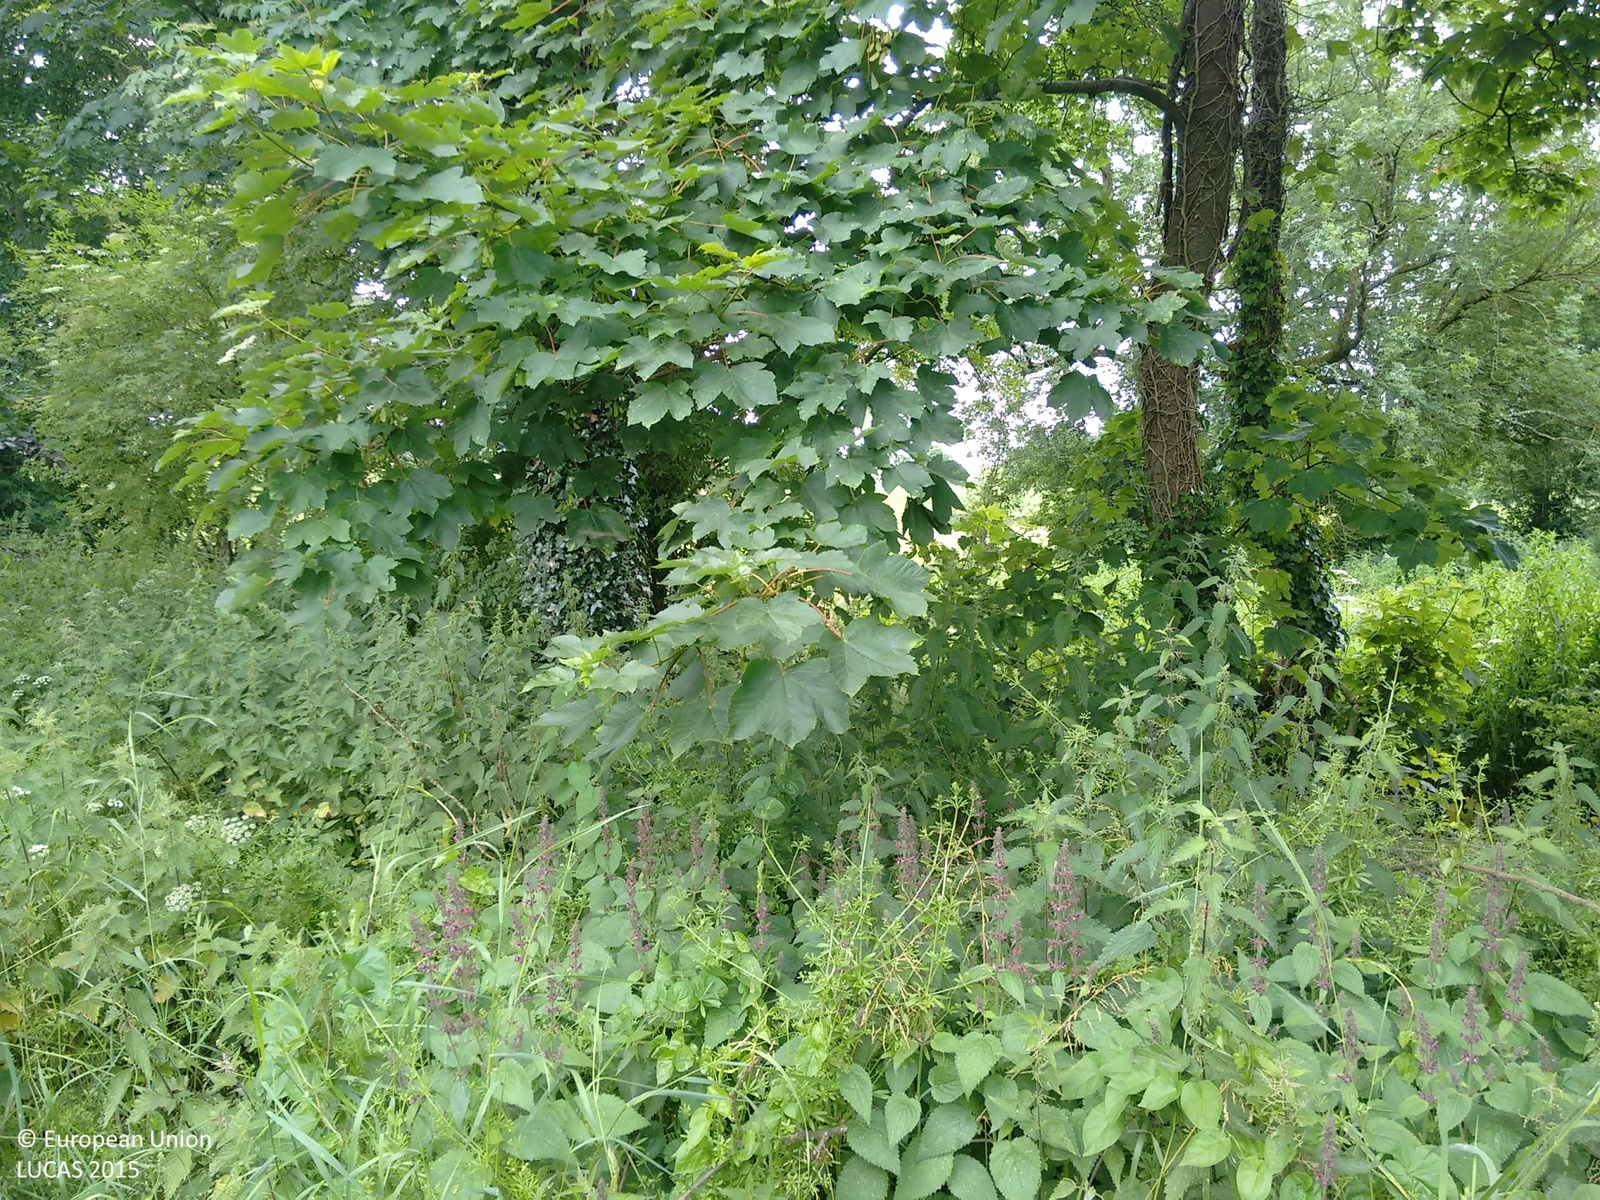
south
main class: Woodland
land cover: Broadleaved woodland
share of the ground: > 75 %
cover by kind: broadleaved forest trees 90 %, shrubs 10 %
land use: Semi-natural and natural areas not in use
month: July
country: IE
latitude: 53.4764
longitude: -7.7498
